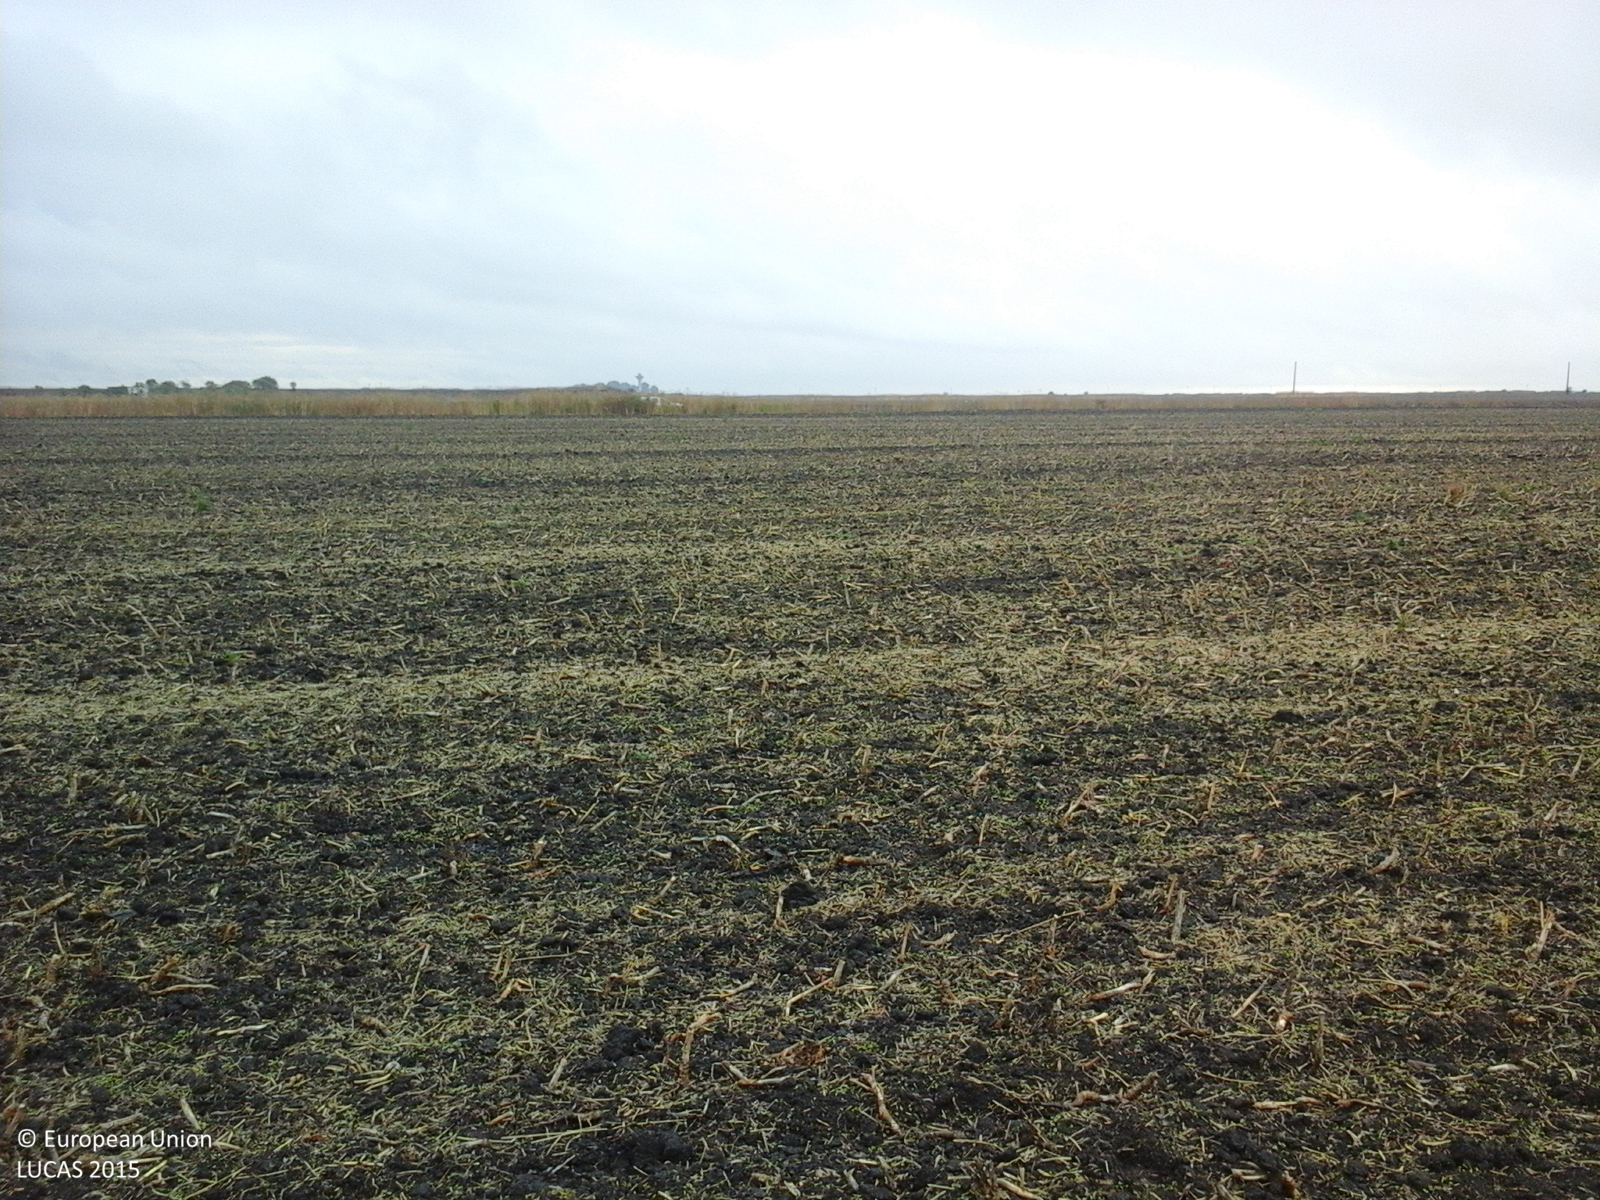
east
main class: Cropland
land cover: Rape and turnip rape
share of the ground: < 10 %
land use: Agriculture (excluding fallow land and kitchen gardens)
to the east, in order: Rape and turnip rape; Ditches and canals; Common wheat
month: August
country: RO
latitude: 45.8492
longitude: 20.7008
